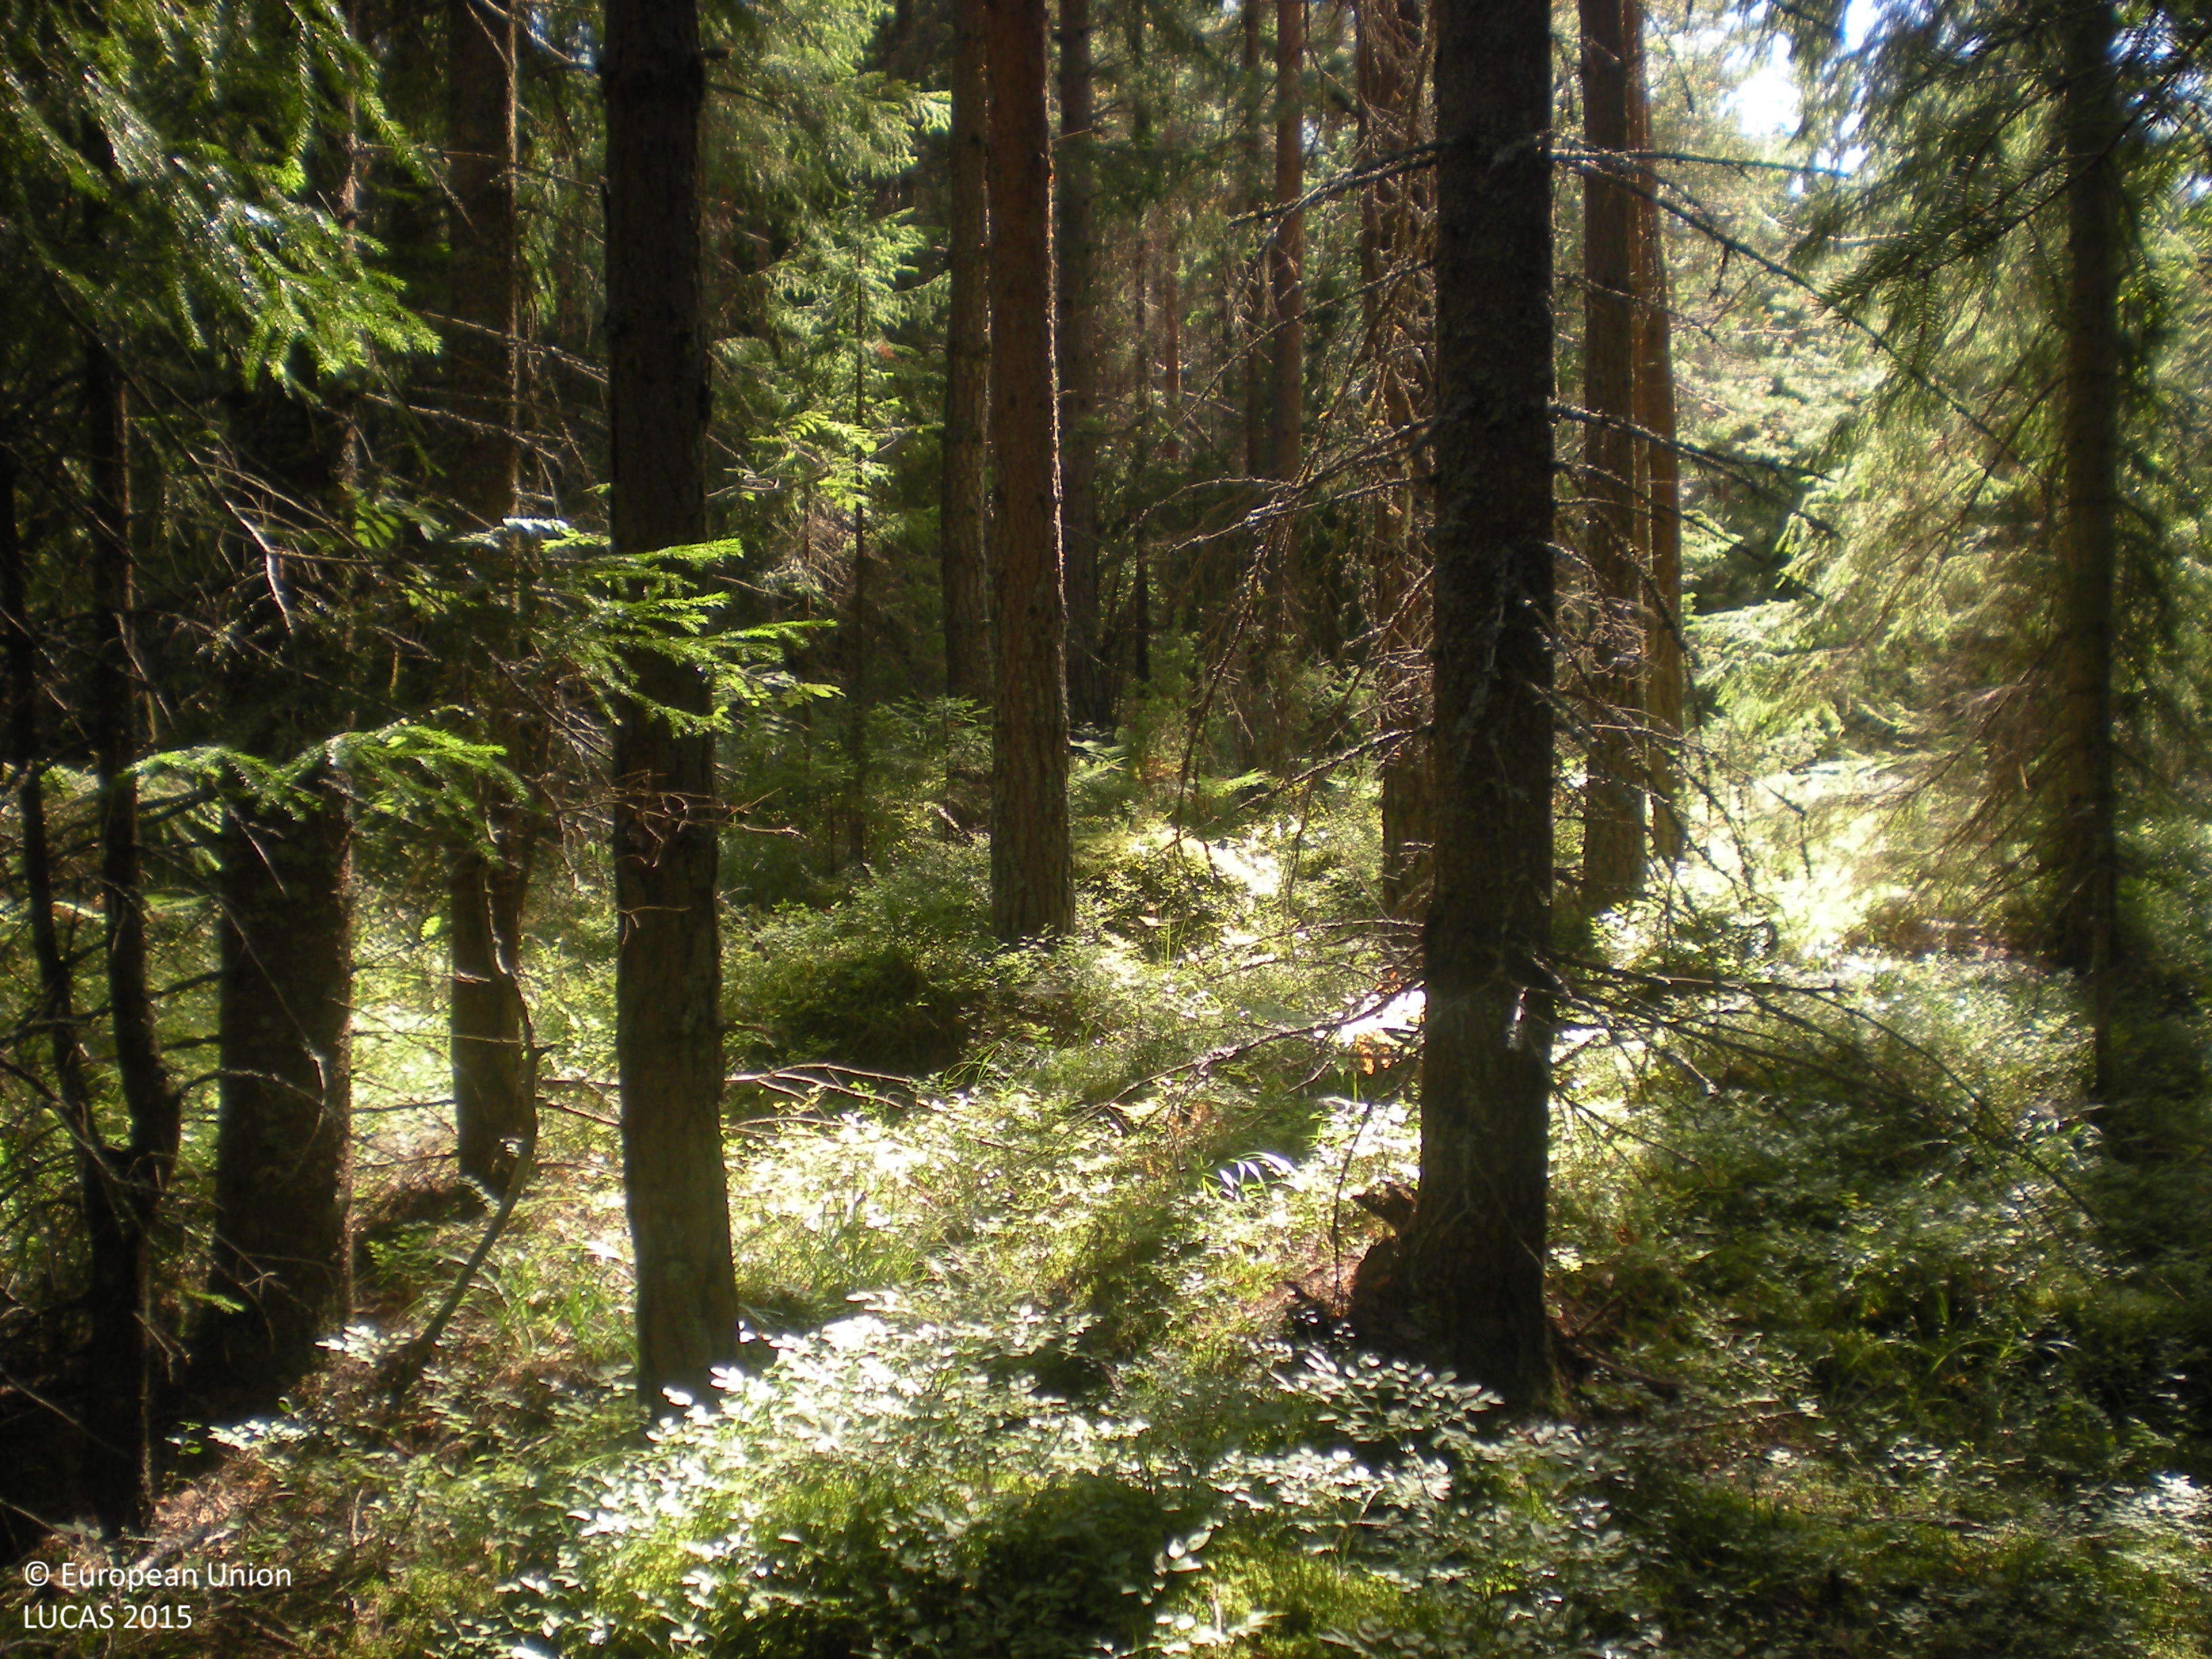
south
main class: Woodland
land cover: Other mixed woodland
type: boreal forest
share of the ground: > 75 %
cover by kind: coniferous forest trees 55 %, broadleaved forest trees 20 %, shrubs 15 %, lichens and mosses 10 %
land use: Forestry
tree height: > 5 m
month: August
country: SE
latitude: 60.5219
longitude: 16.8207
